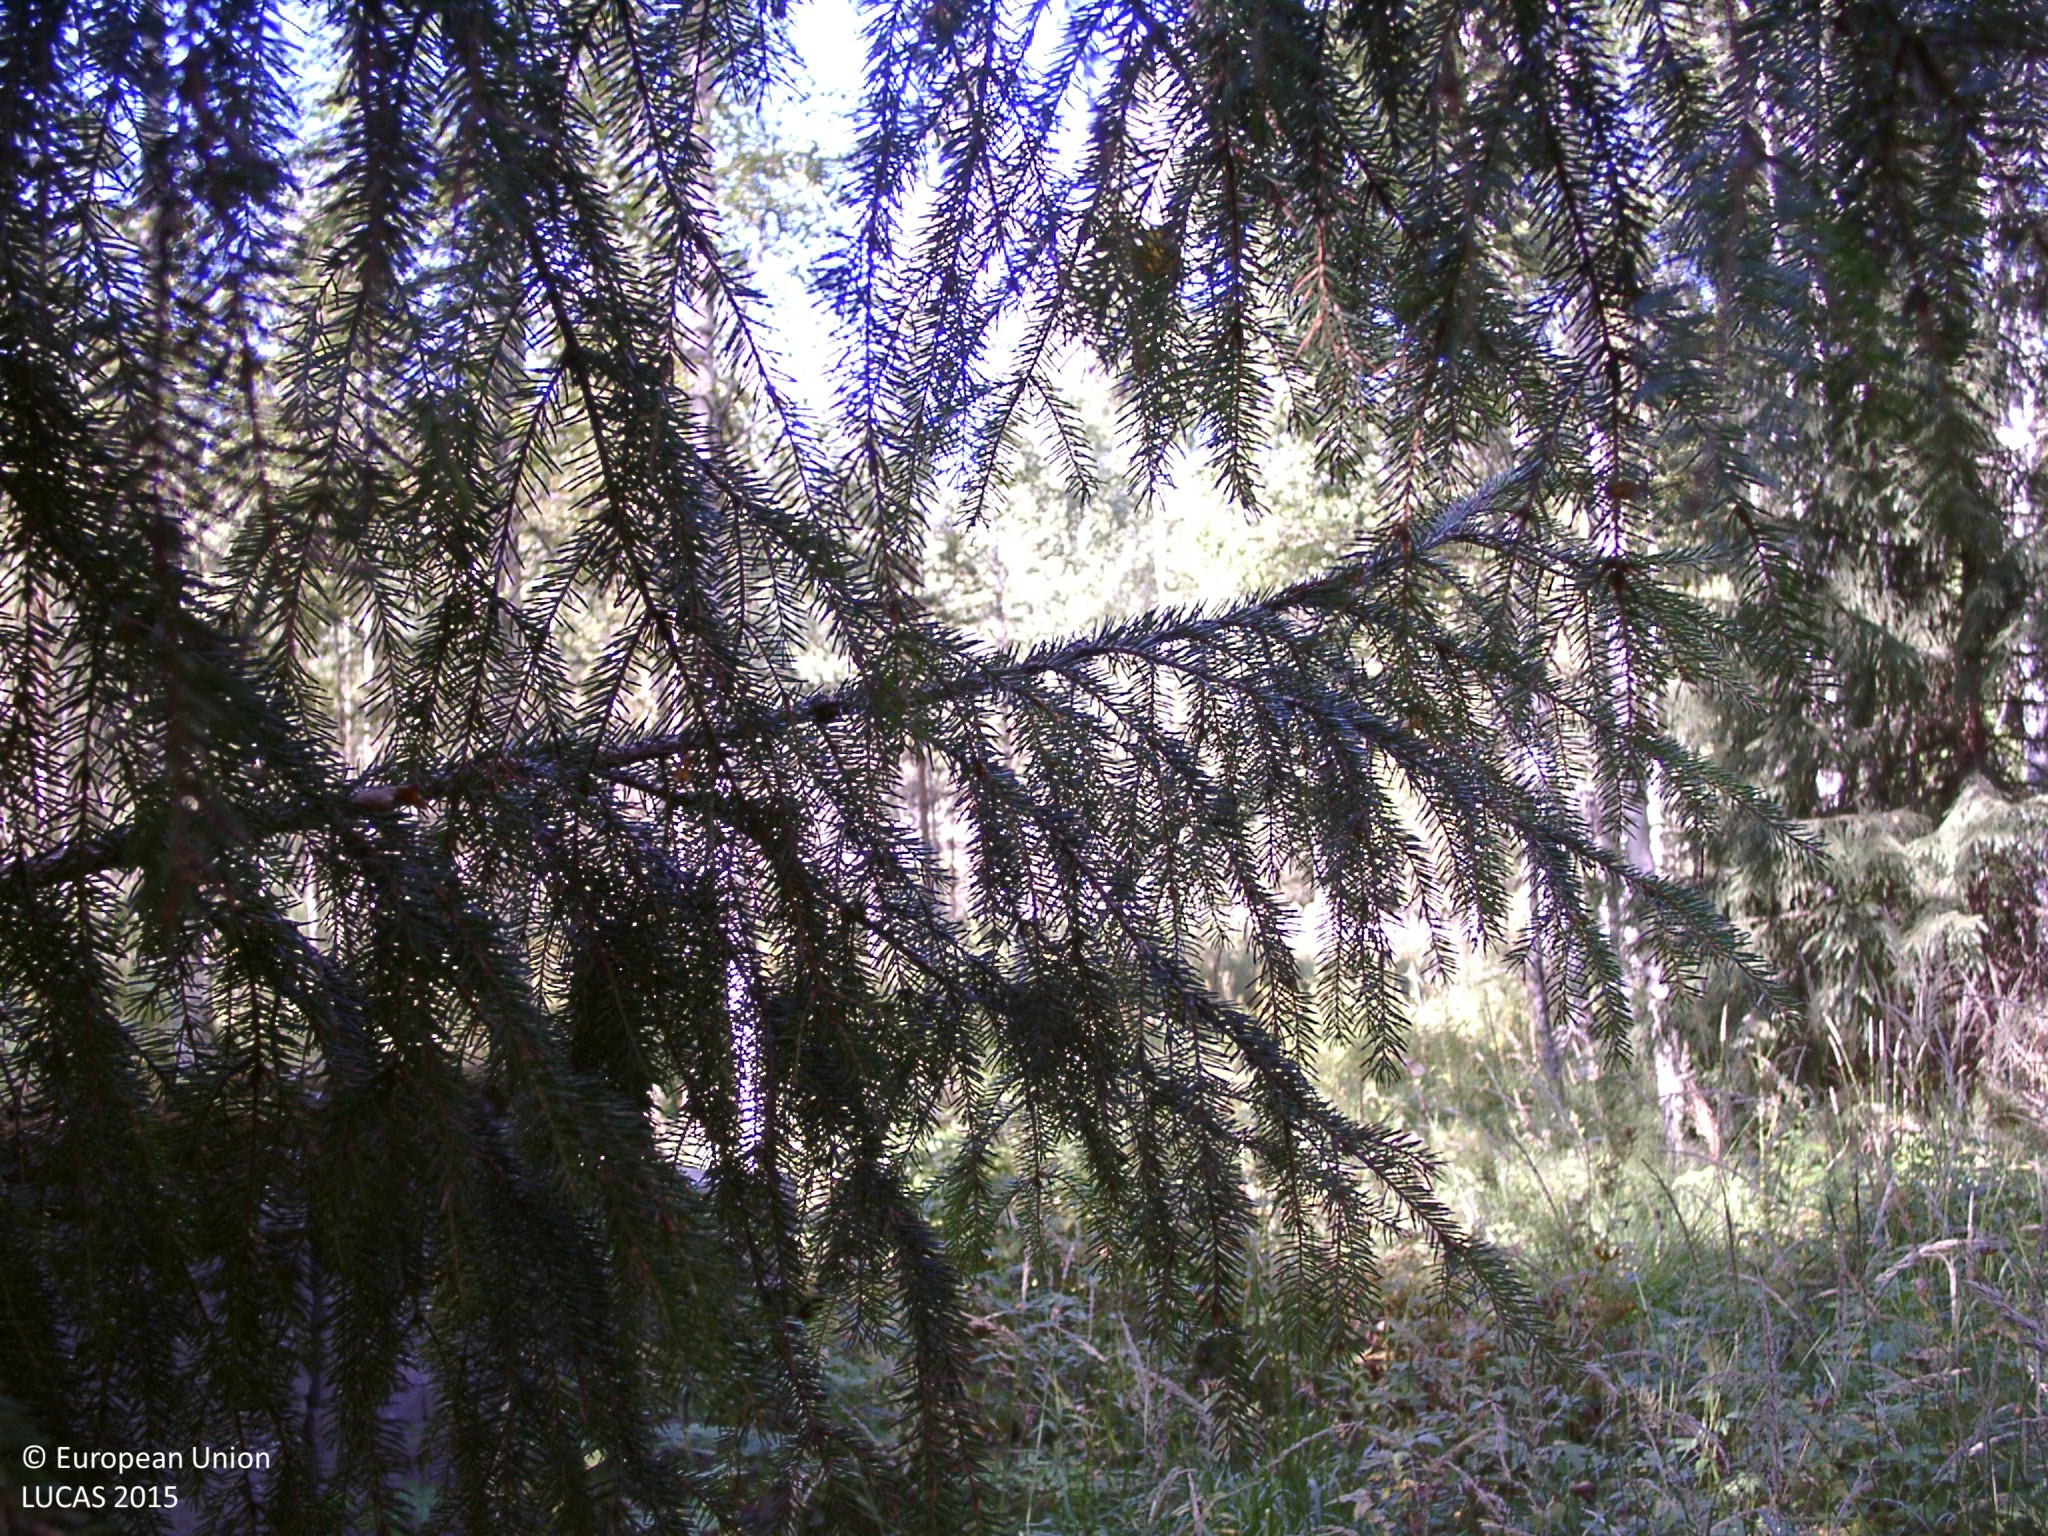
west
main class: Woodland
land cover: Broadleaved woodland
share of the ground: 50 - 75 %
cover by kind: broadleaved forest trees 55 %, herbaceous plants 30 %, coniferous forest trees 15 %
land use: Forestry
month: August
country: FI
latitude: 61.9613
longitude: 25.0376
